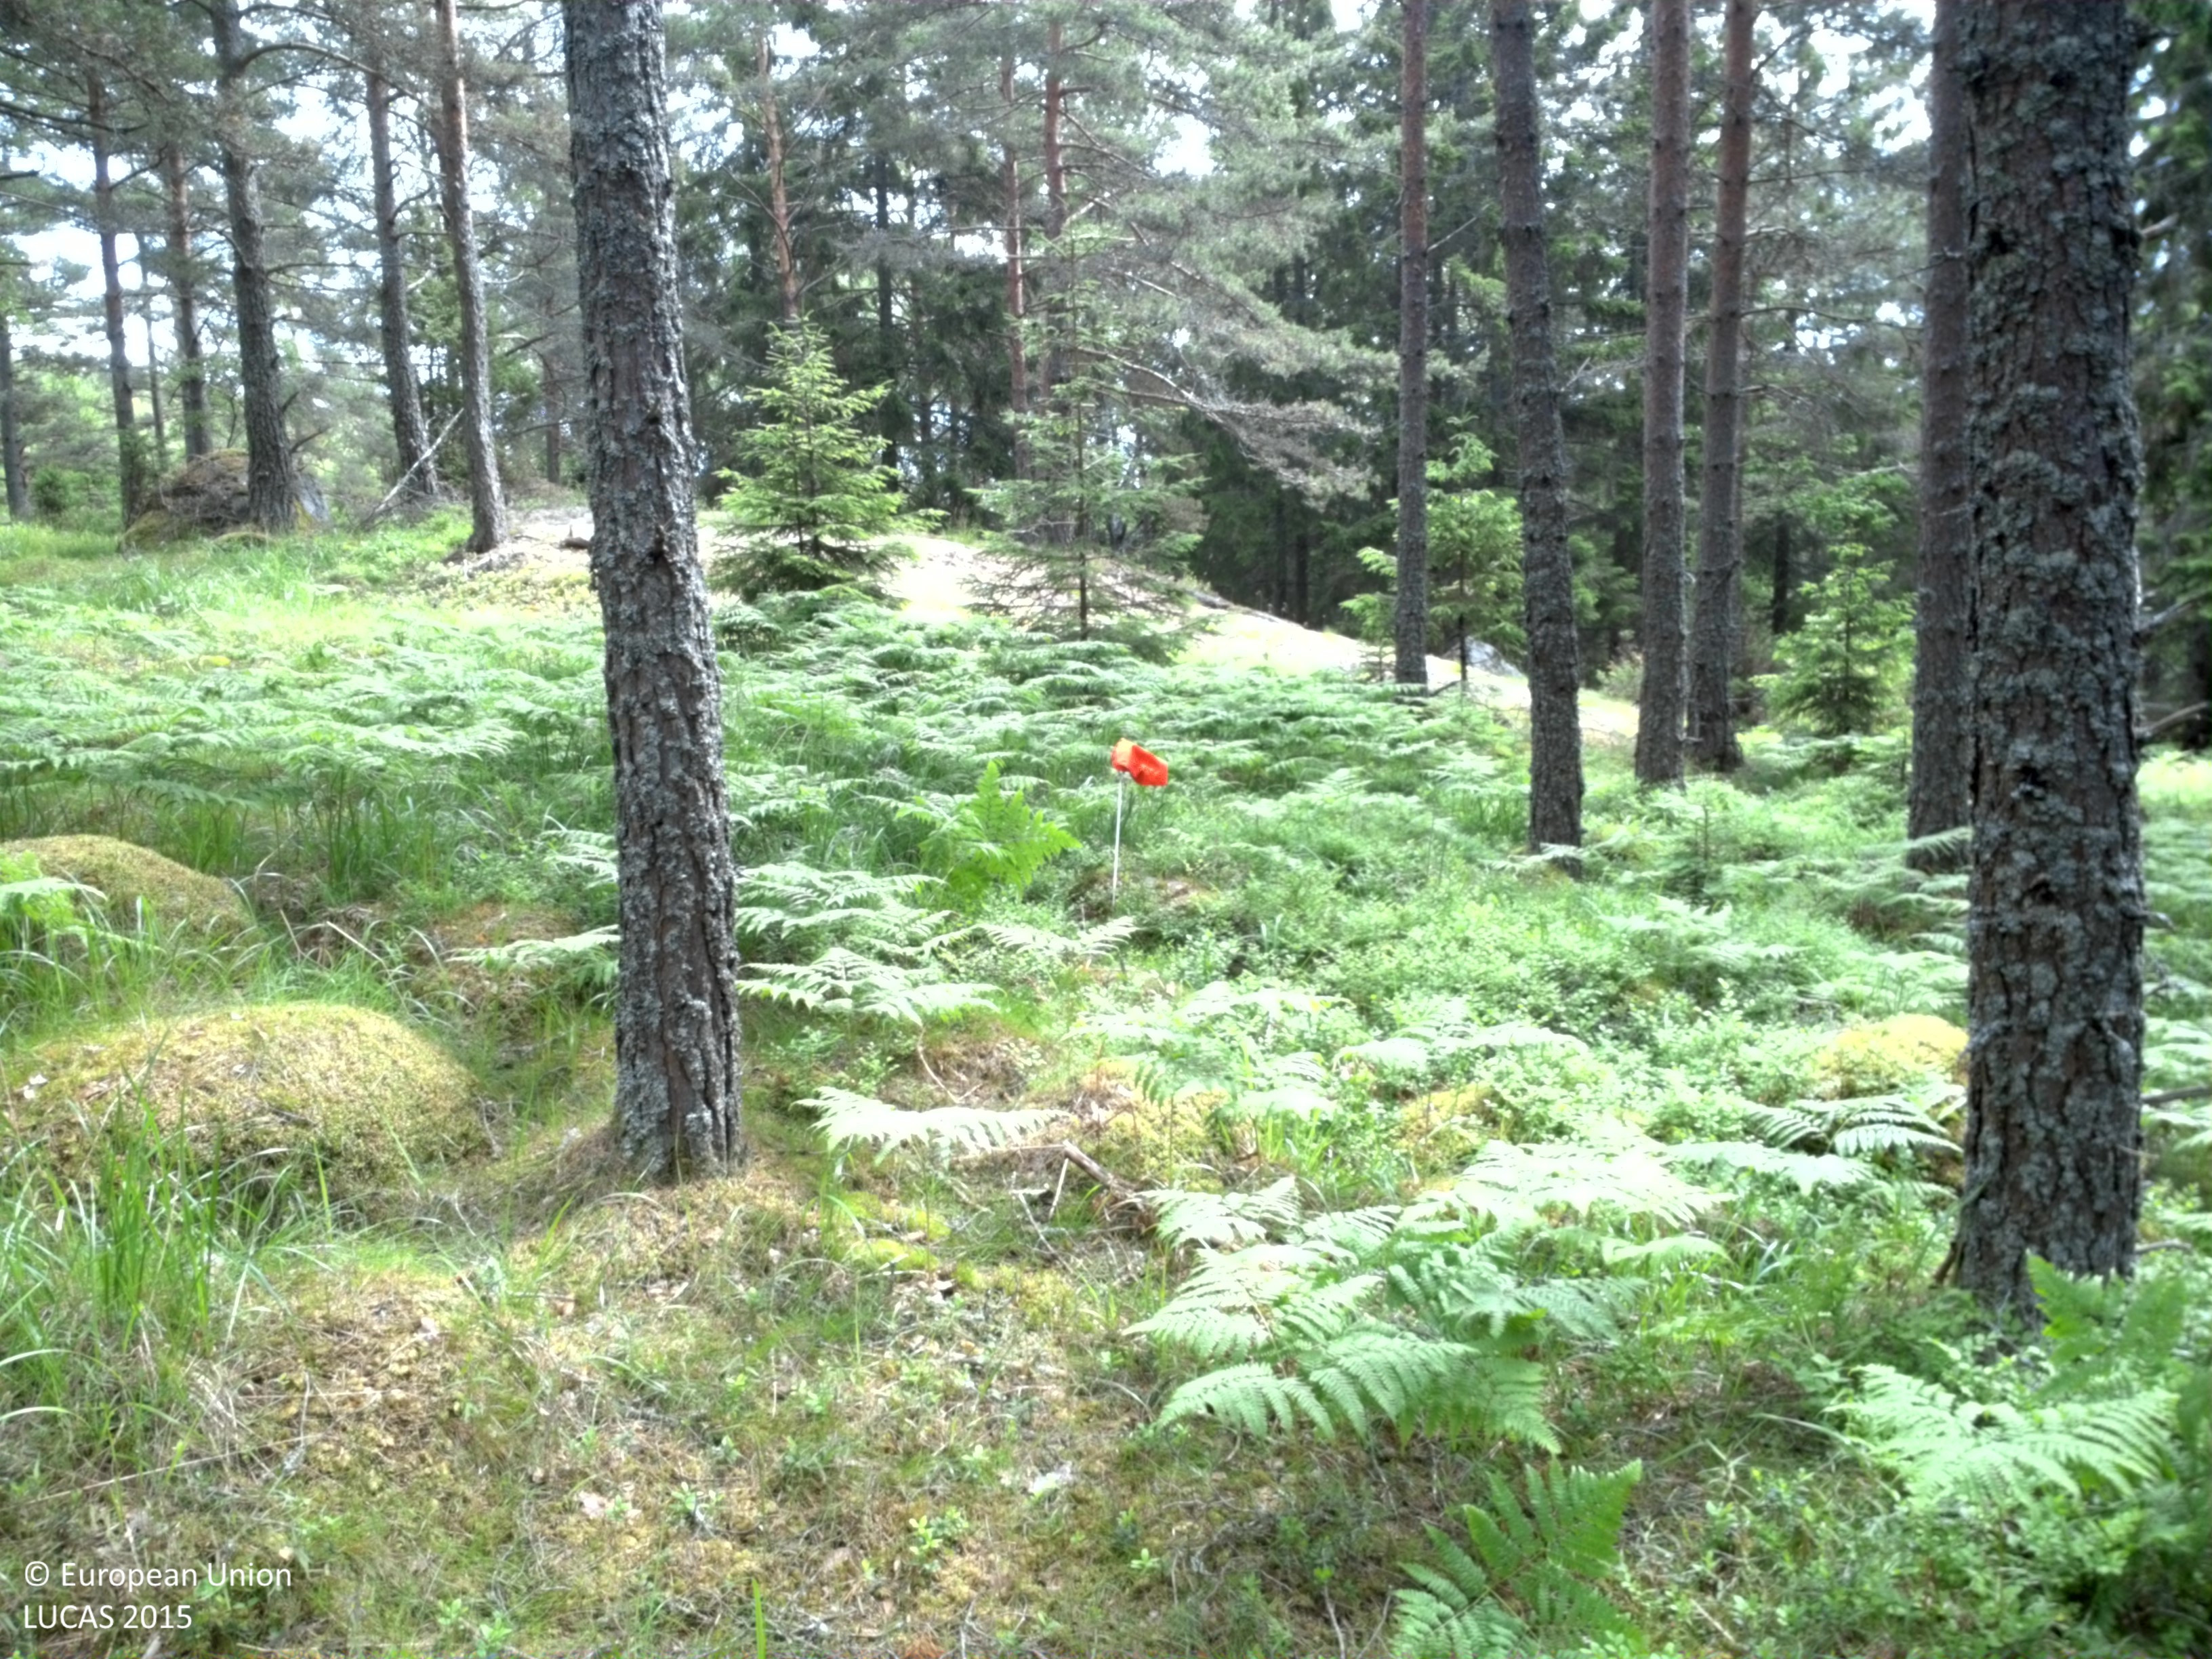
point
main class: Woodland
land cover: Pine dominated coniferous woodland
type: boreal forest
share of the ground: 25 - 50 %
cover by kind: herbaceous plants 55 %, coniferous forest trees 35 %, lichens and mosses 10 %
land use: Forestry
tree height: > 5 m
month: June
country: SE
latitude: 58.5697
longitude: 15.6508
